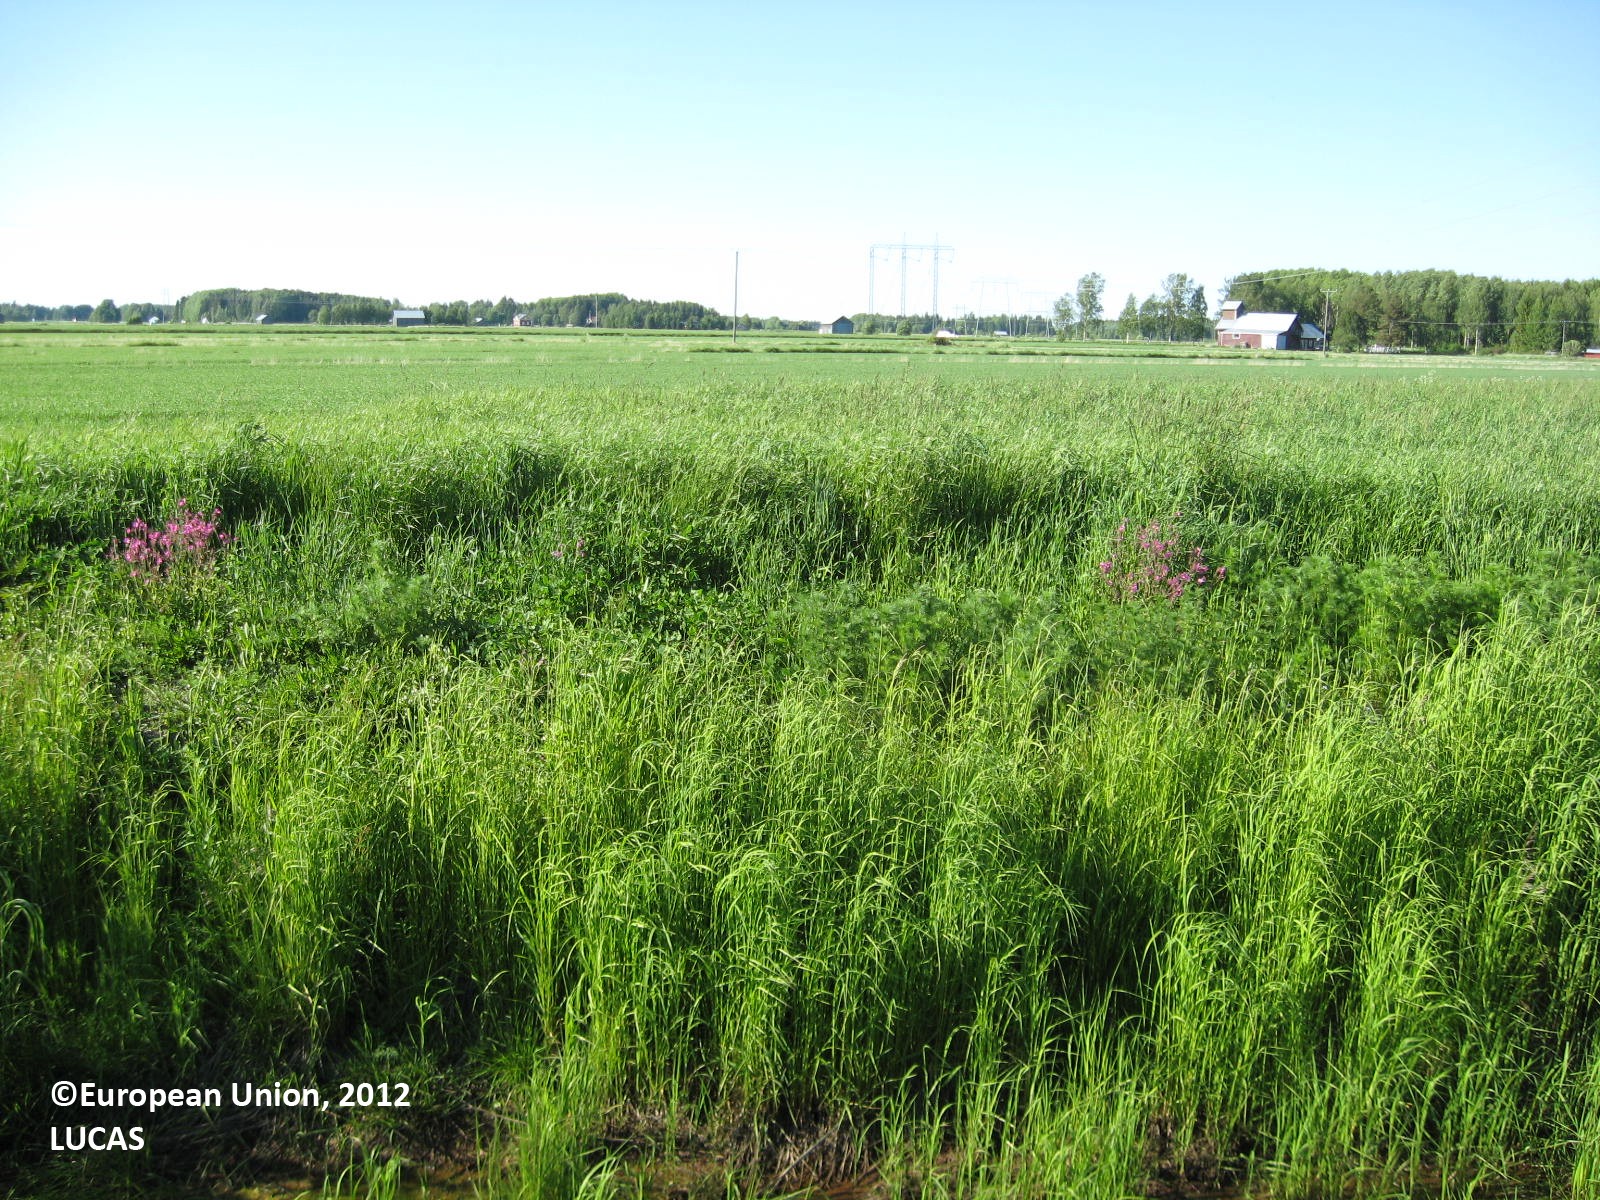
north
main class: Cropland
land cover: Temporary grasslands
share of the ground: > 75 %
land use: Agriculture (excluding fallow land and kitchen gardens)
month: June
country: FI
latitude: 63.0030
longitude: 21.8314
